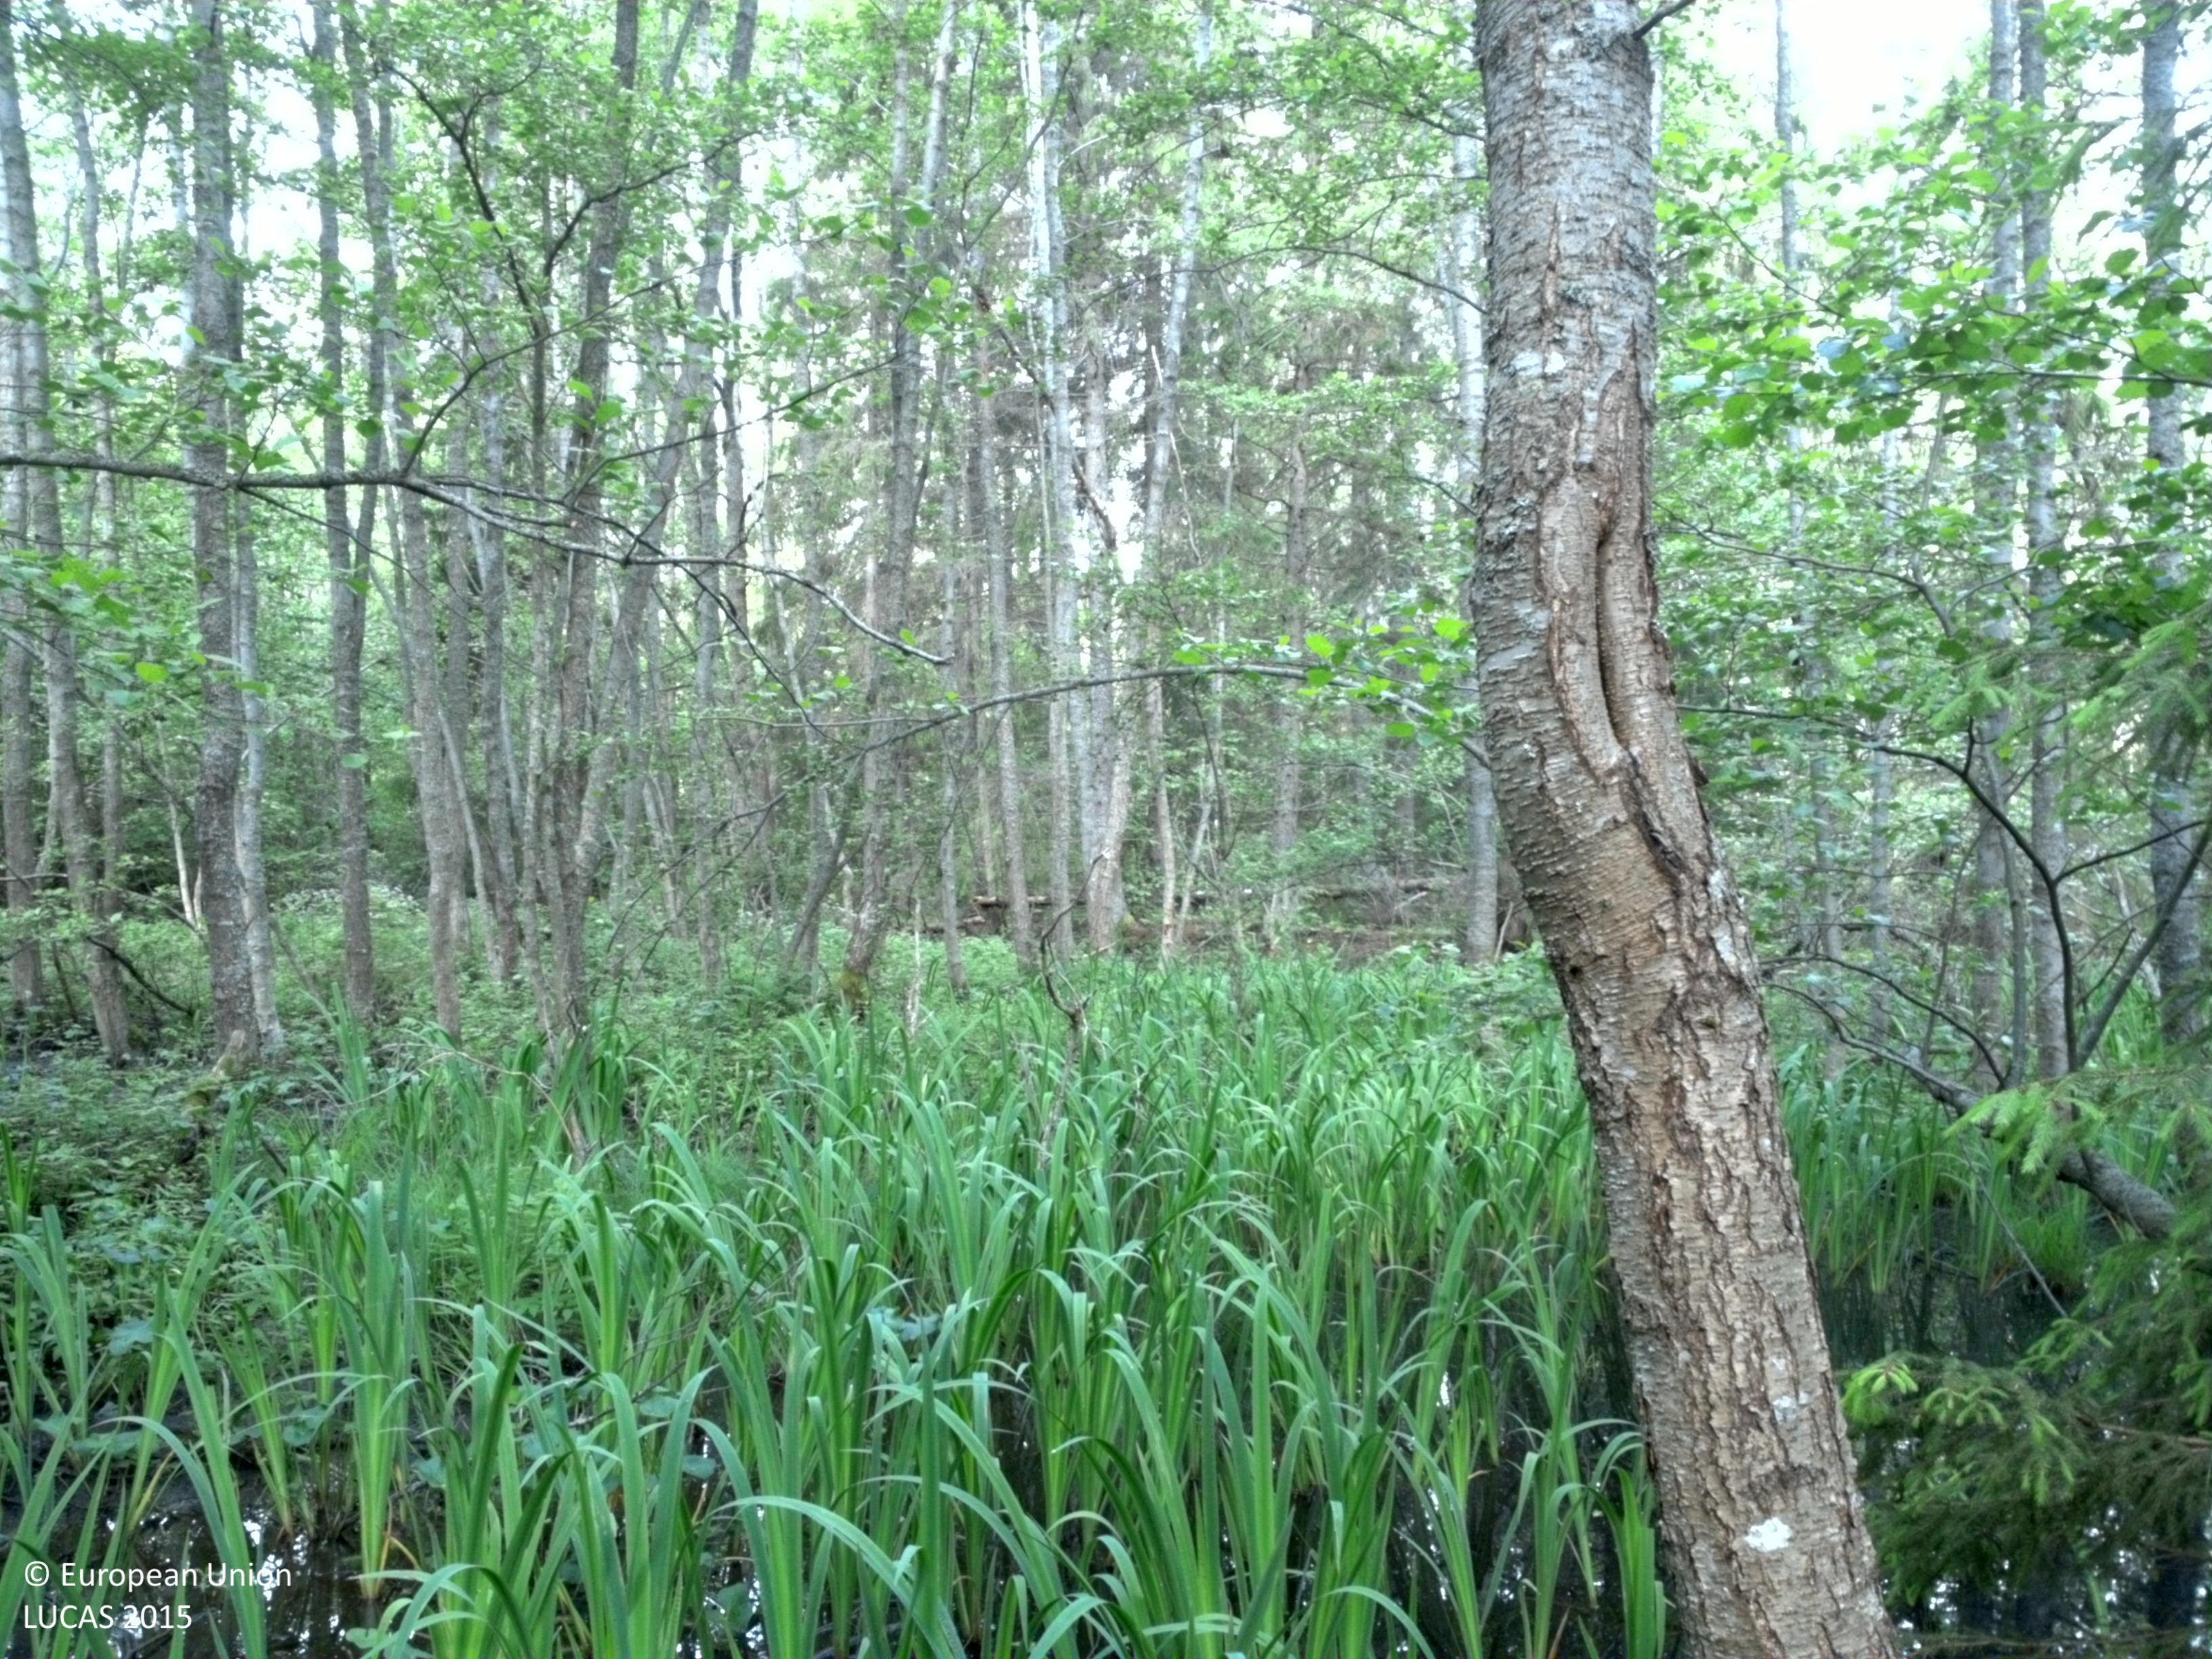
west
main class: Woodland
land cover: Spruce dominated mixed woodland
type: boreal forest
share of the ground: > 75 %
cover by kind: coniferous forest trees 60 %, broadleaved forest trees 20 %, herbaceous plants 10 %, lichens and mosses 10 %
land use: Forestry
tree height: > 5 m
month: June
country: SE
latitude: 60.0895
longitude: 18.7542
